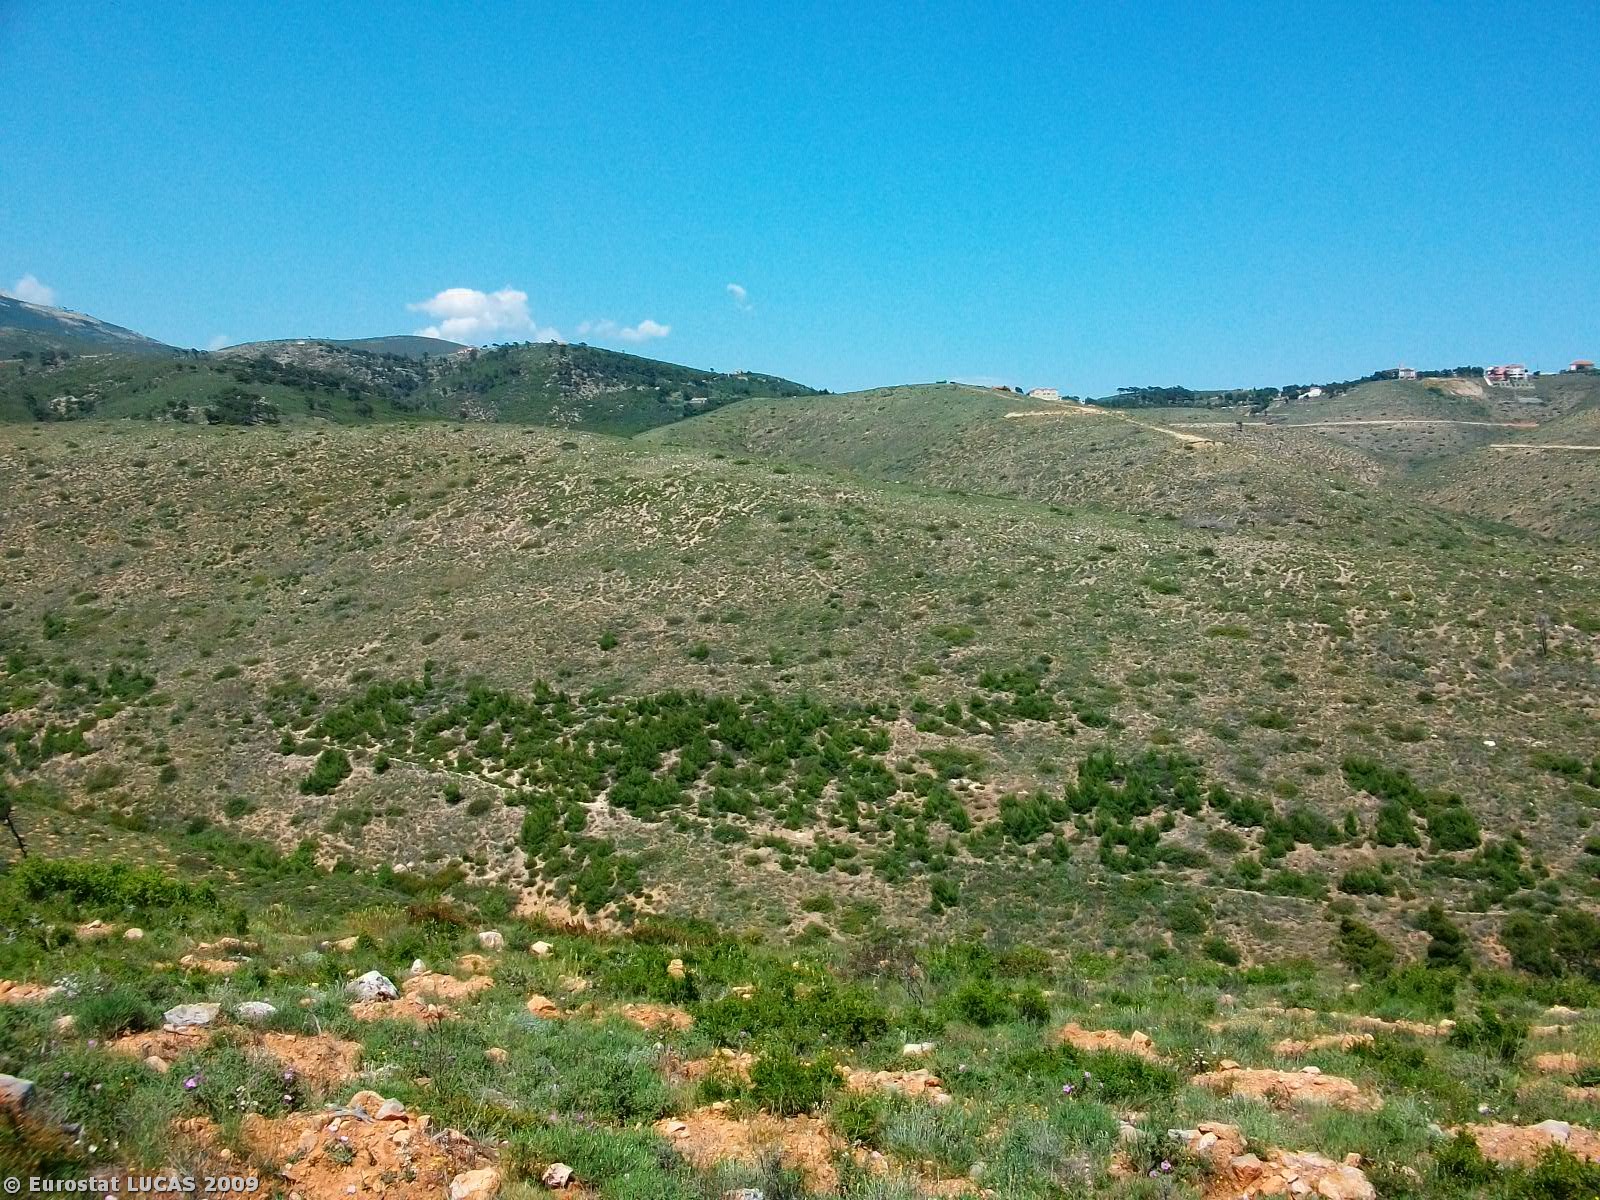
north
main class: Shrubland
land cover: Shrubland without tree cover
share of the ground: > 75 %
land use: Unused
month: May
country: GR
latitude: 38.0342
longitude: 23.9634
